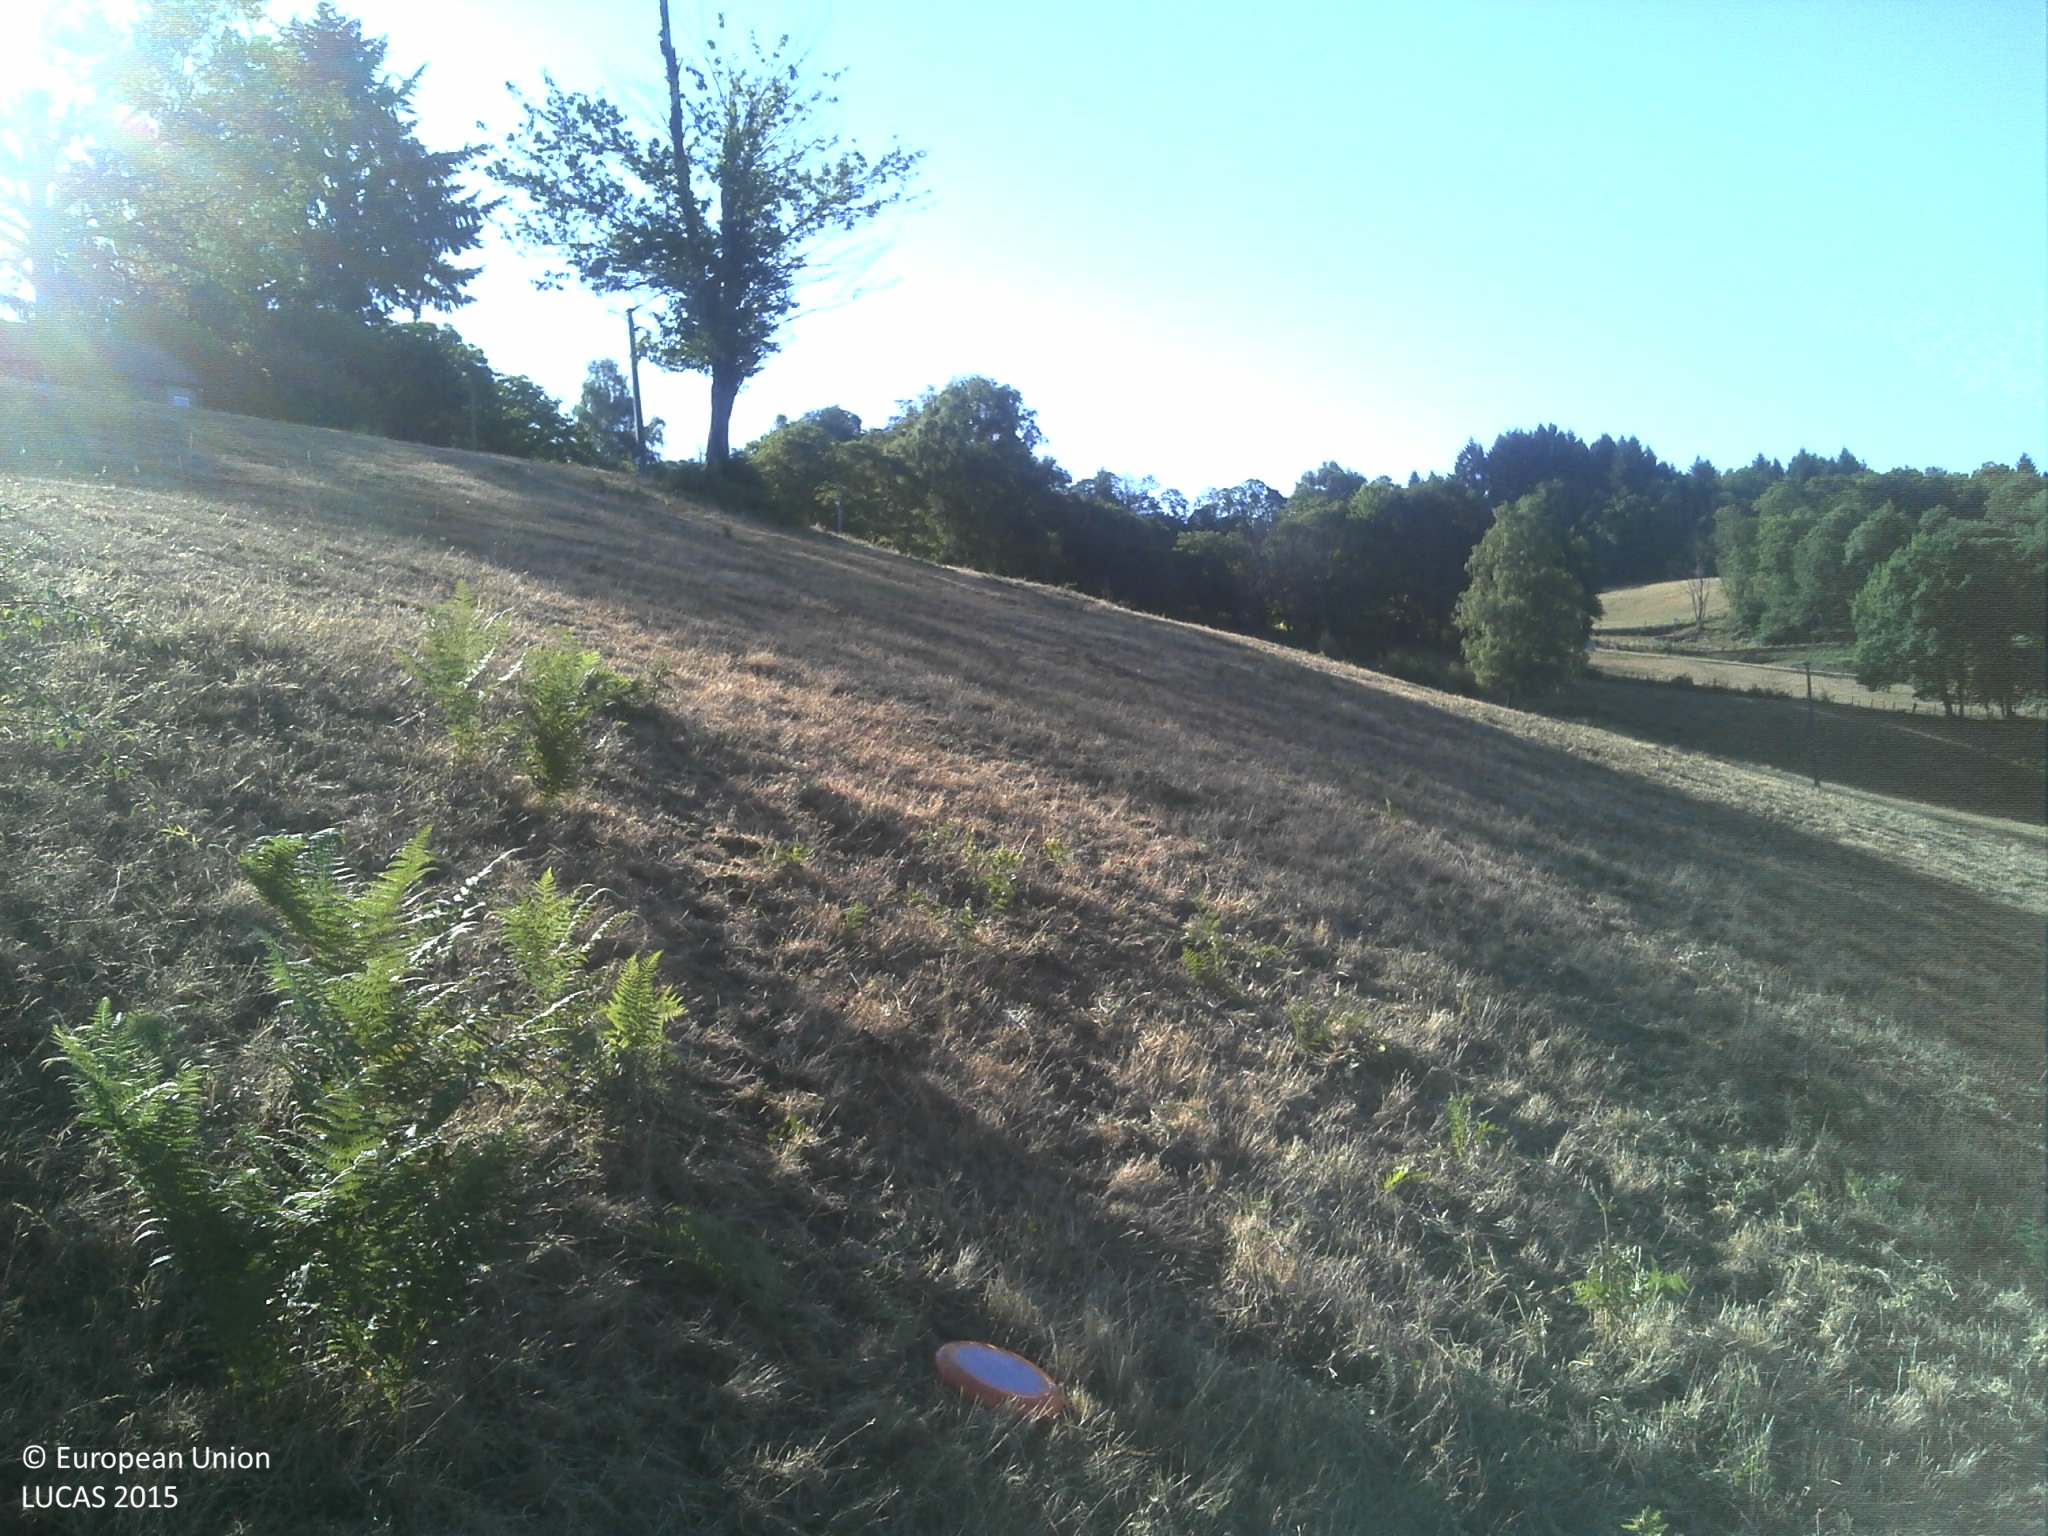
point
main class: Grassland
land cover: Grassland with sparse tree/shrub cover
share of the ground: > 75 %
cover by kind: herbaceous plants 95 %, broadleaved forest trees 5 %
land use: Agriculture (excluding fallow land and kitchen gardens)
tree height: > 5 m
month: July
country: FR
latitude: 45.1085
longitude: 1.7479
